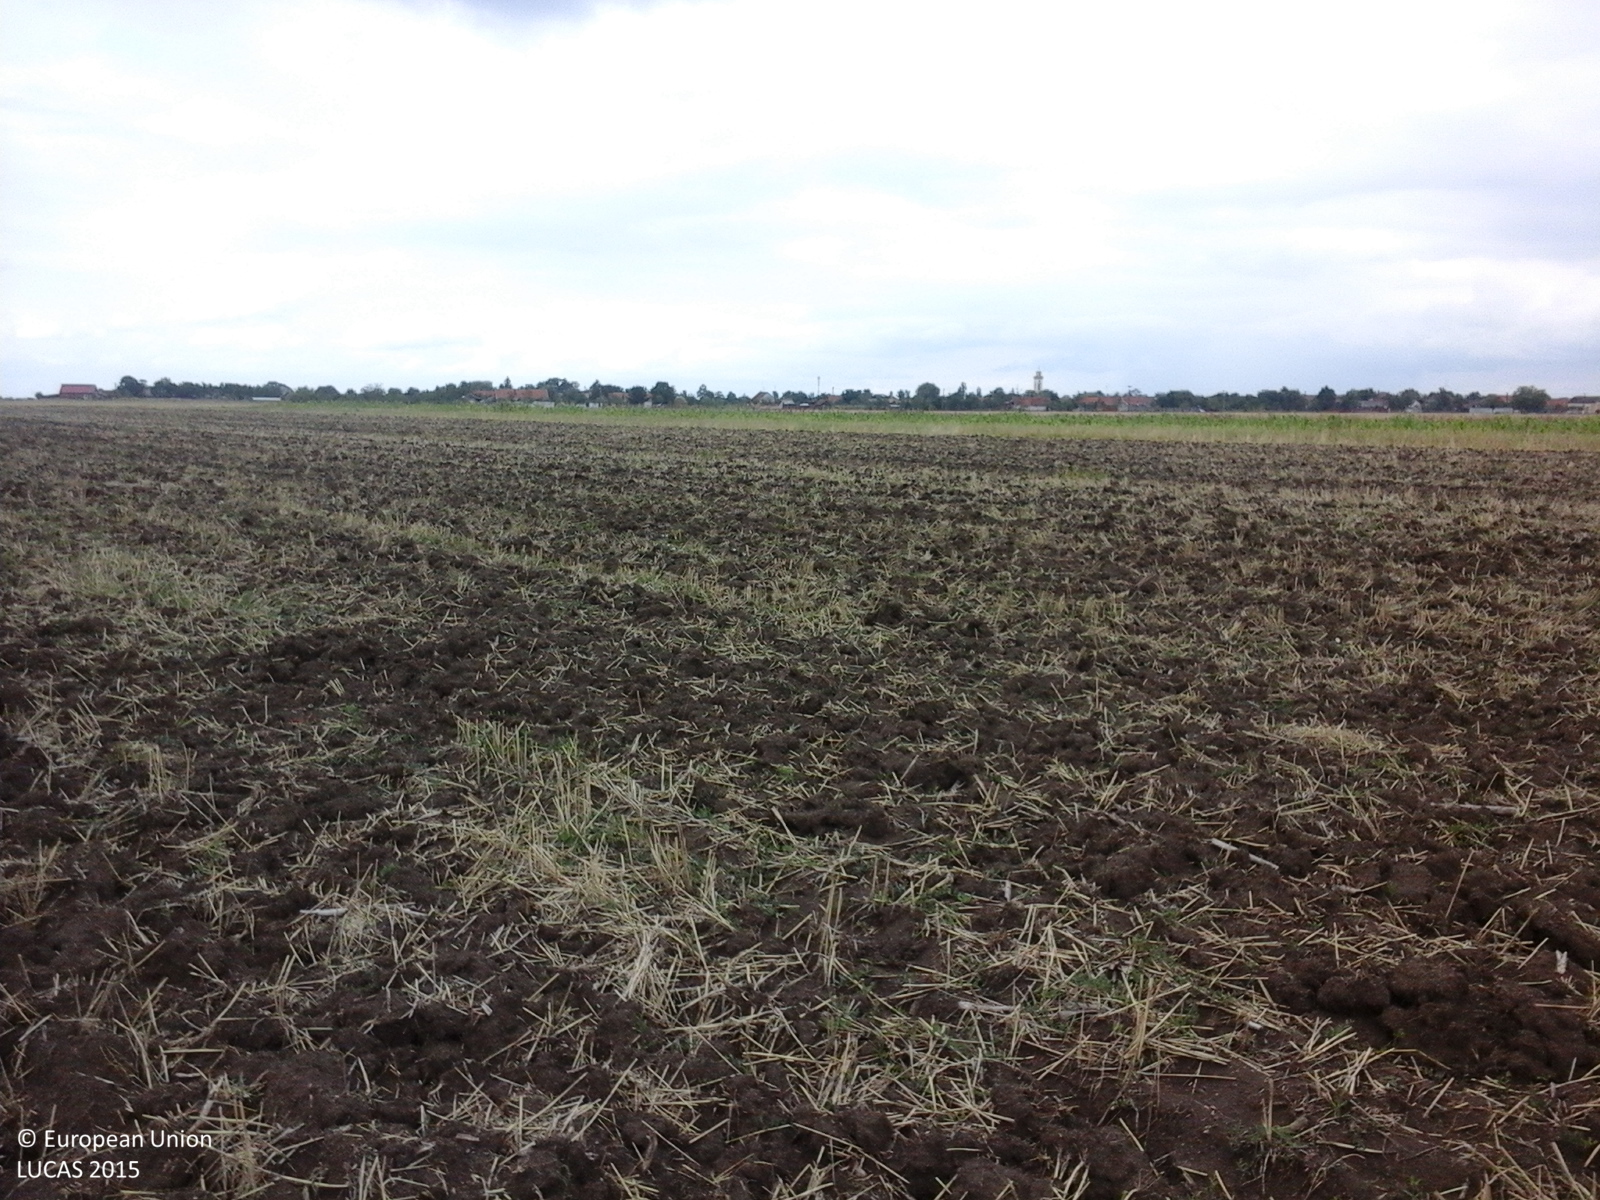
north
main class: Cropland
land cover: Common wheat
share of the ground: 10 - 25 %
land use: Agriculture (excluding fallow land and kitchen gardens)
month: August
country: RO
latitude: 45.5117
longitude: 21.4885
